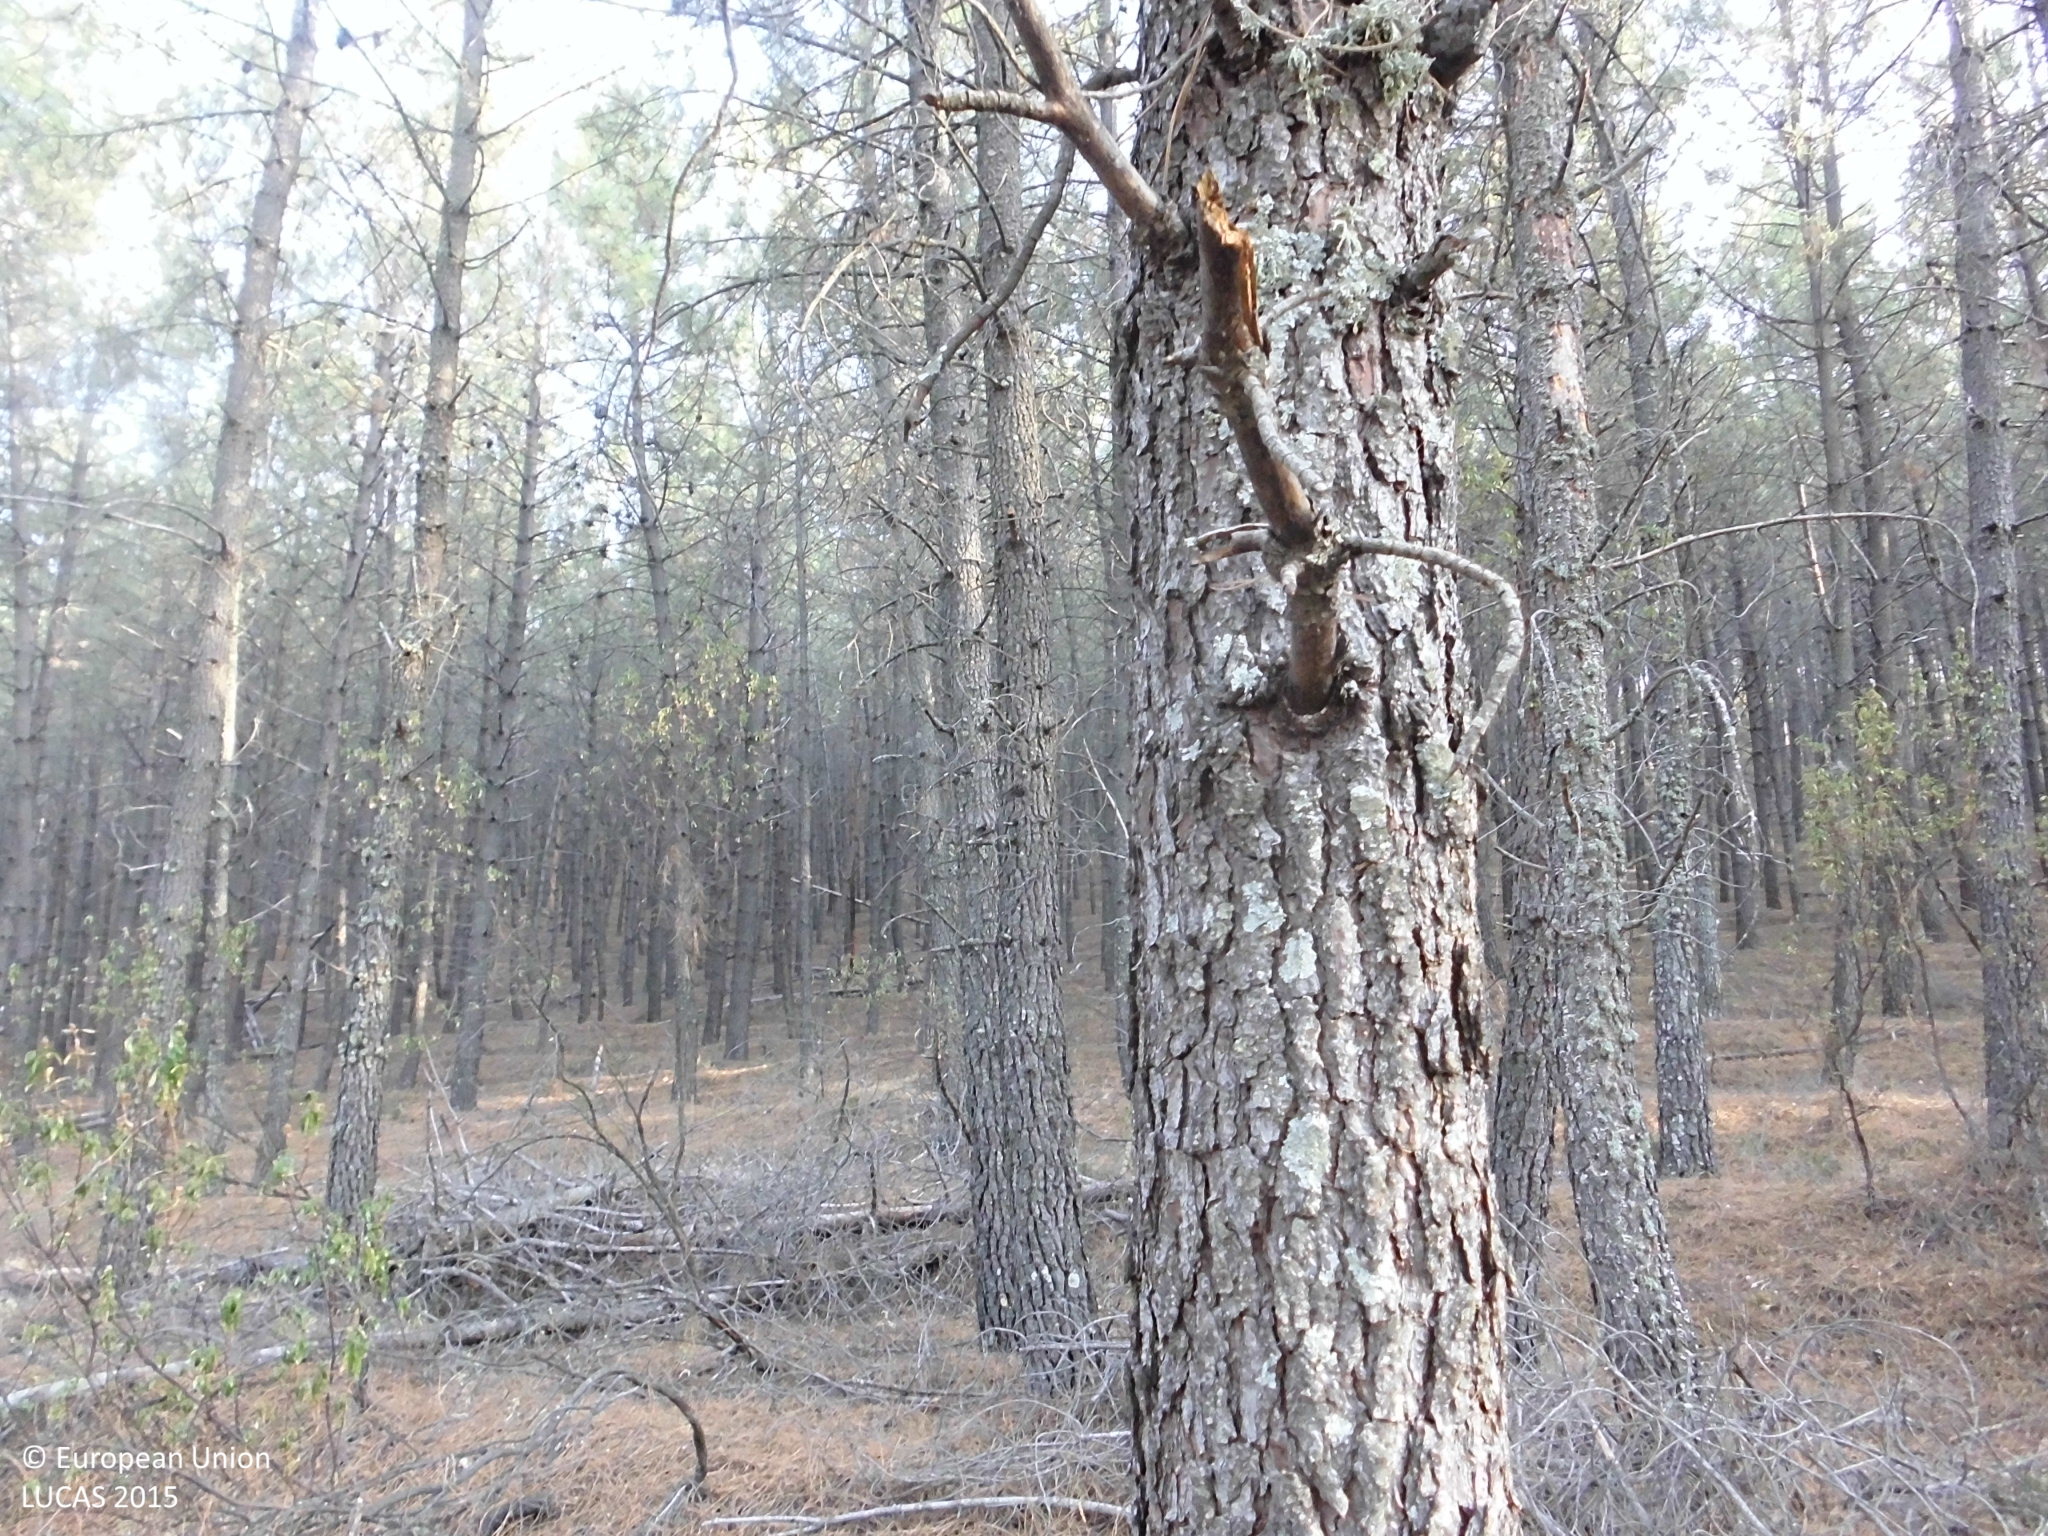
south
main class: Woodland
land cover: Pine dominated coniferous woodland
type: coniferous forest of the mediterranean region
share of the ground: > 75 %
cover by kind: coniferous forest trees 85 %, shrubs 10 %, herbaceous plants 5 %
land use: Forestry
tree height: > 5 m
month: July
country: ES
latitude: 39.7227
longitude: -5.6323
